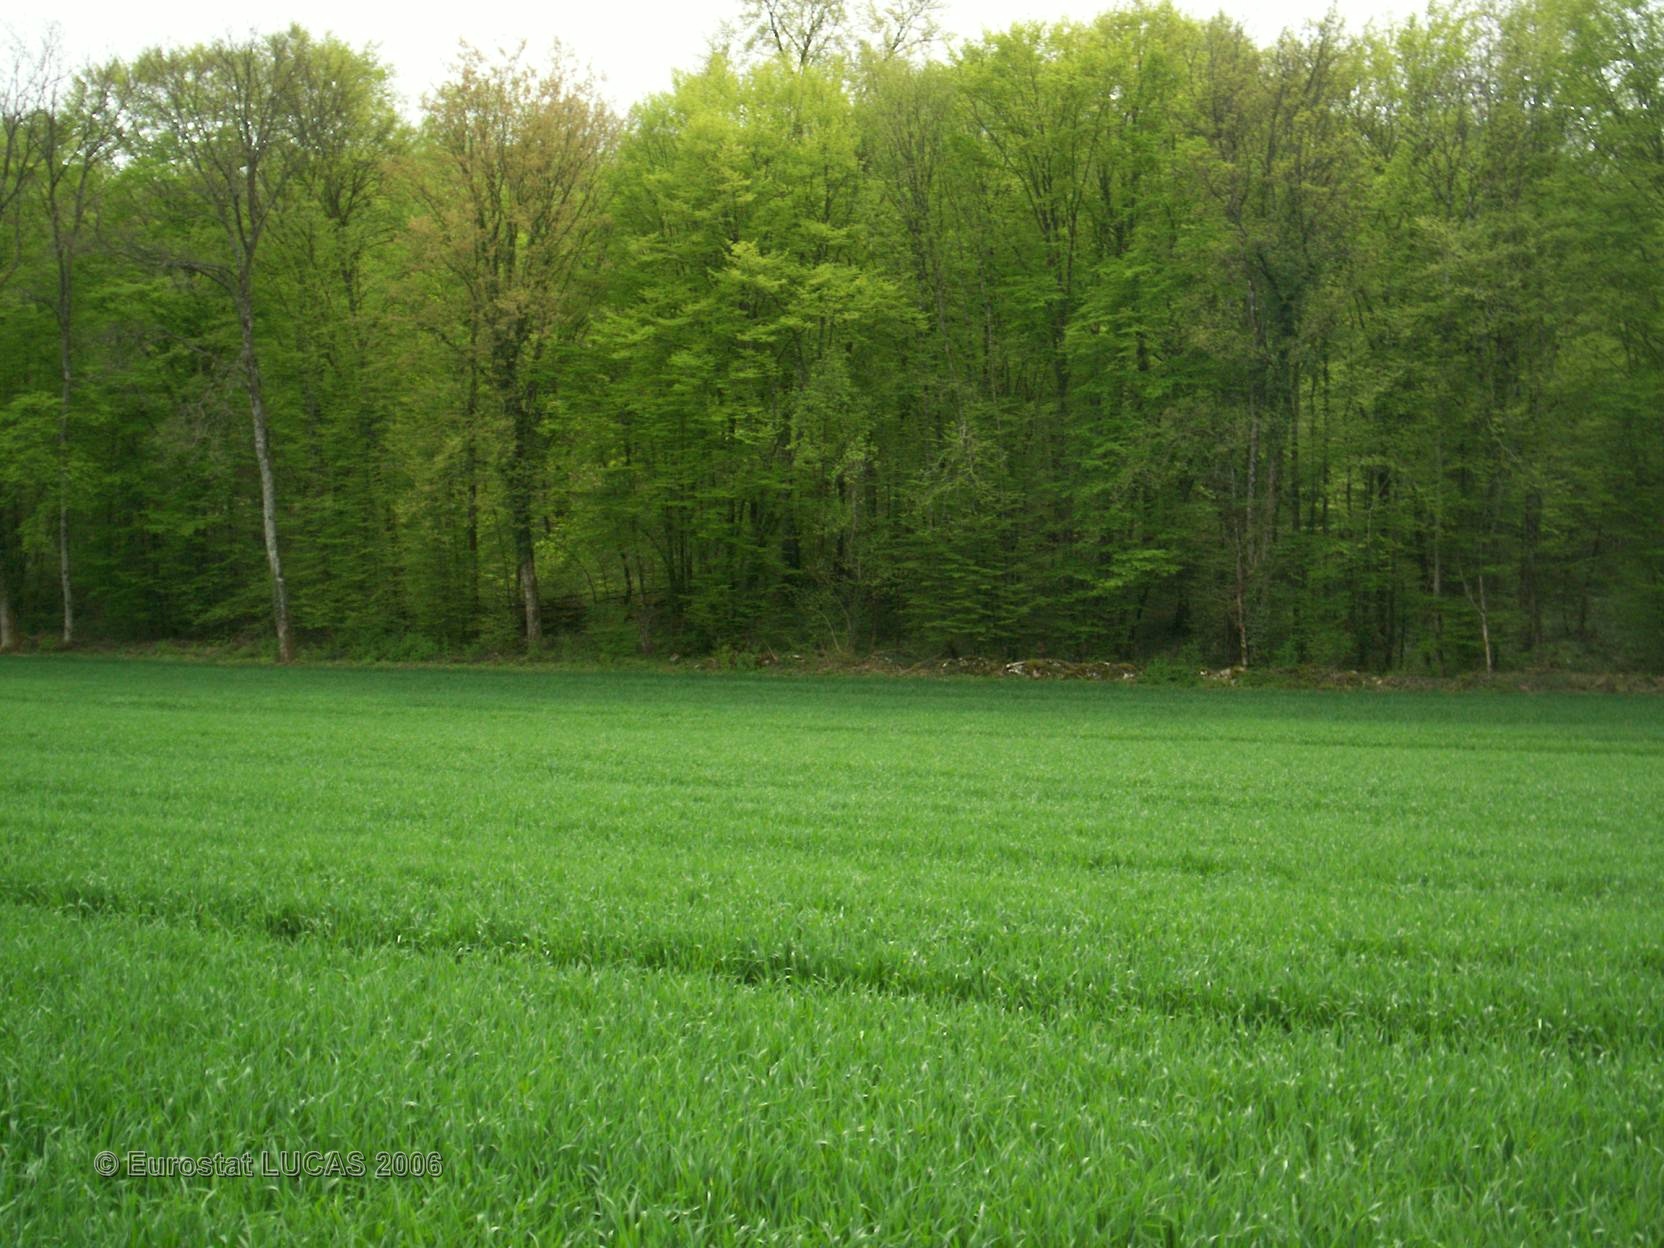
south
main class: Cropland
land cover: Common wheat
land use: Agriculture (excluding fallow land and kitchen gardens)
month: May
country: FR
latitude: 47.6740
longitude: 4.5513
